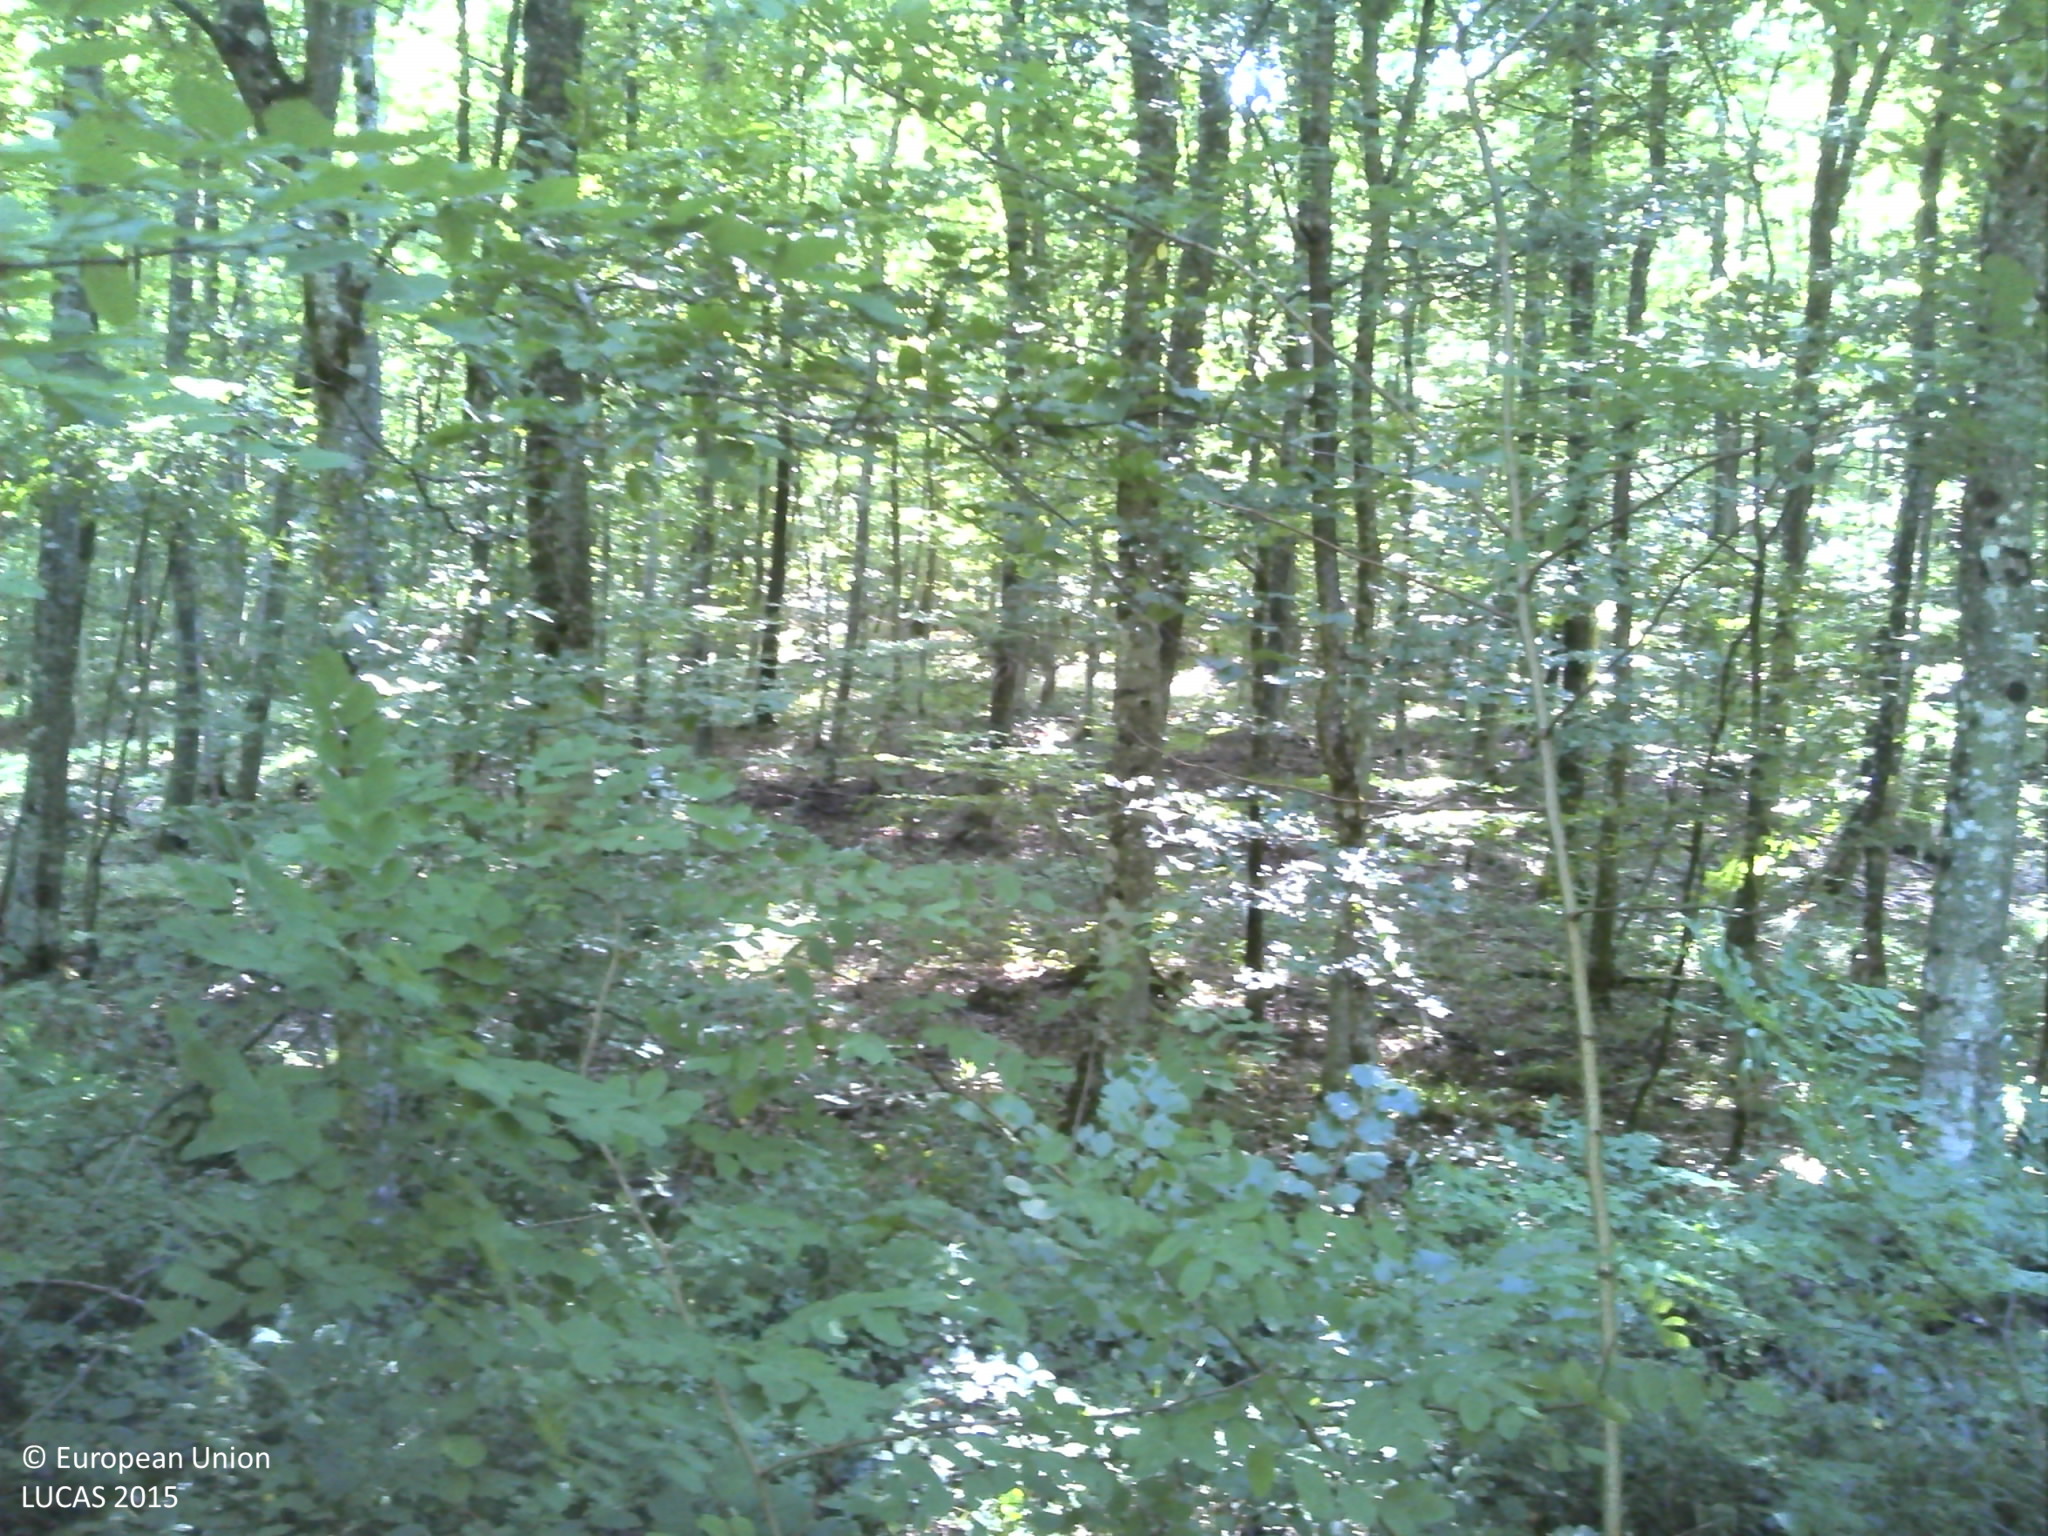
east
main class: Woodland
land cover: Broadleaved woodland
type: acidophilous oak and oak-birch forest
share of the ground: > 75 %
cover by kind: broadleaved forest trees 85 %, shrubs 15 %
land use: Forestry
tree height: > 5 m
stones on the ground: < 10 %
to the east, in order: Broadleaved woodland
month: August
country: HR
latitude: 45.2675
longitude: 17.5844
